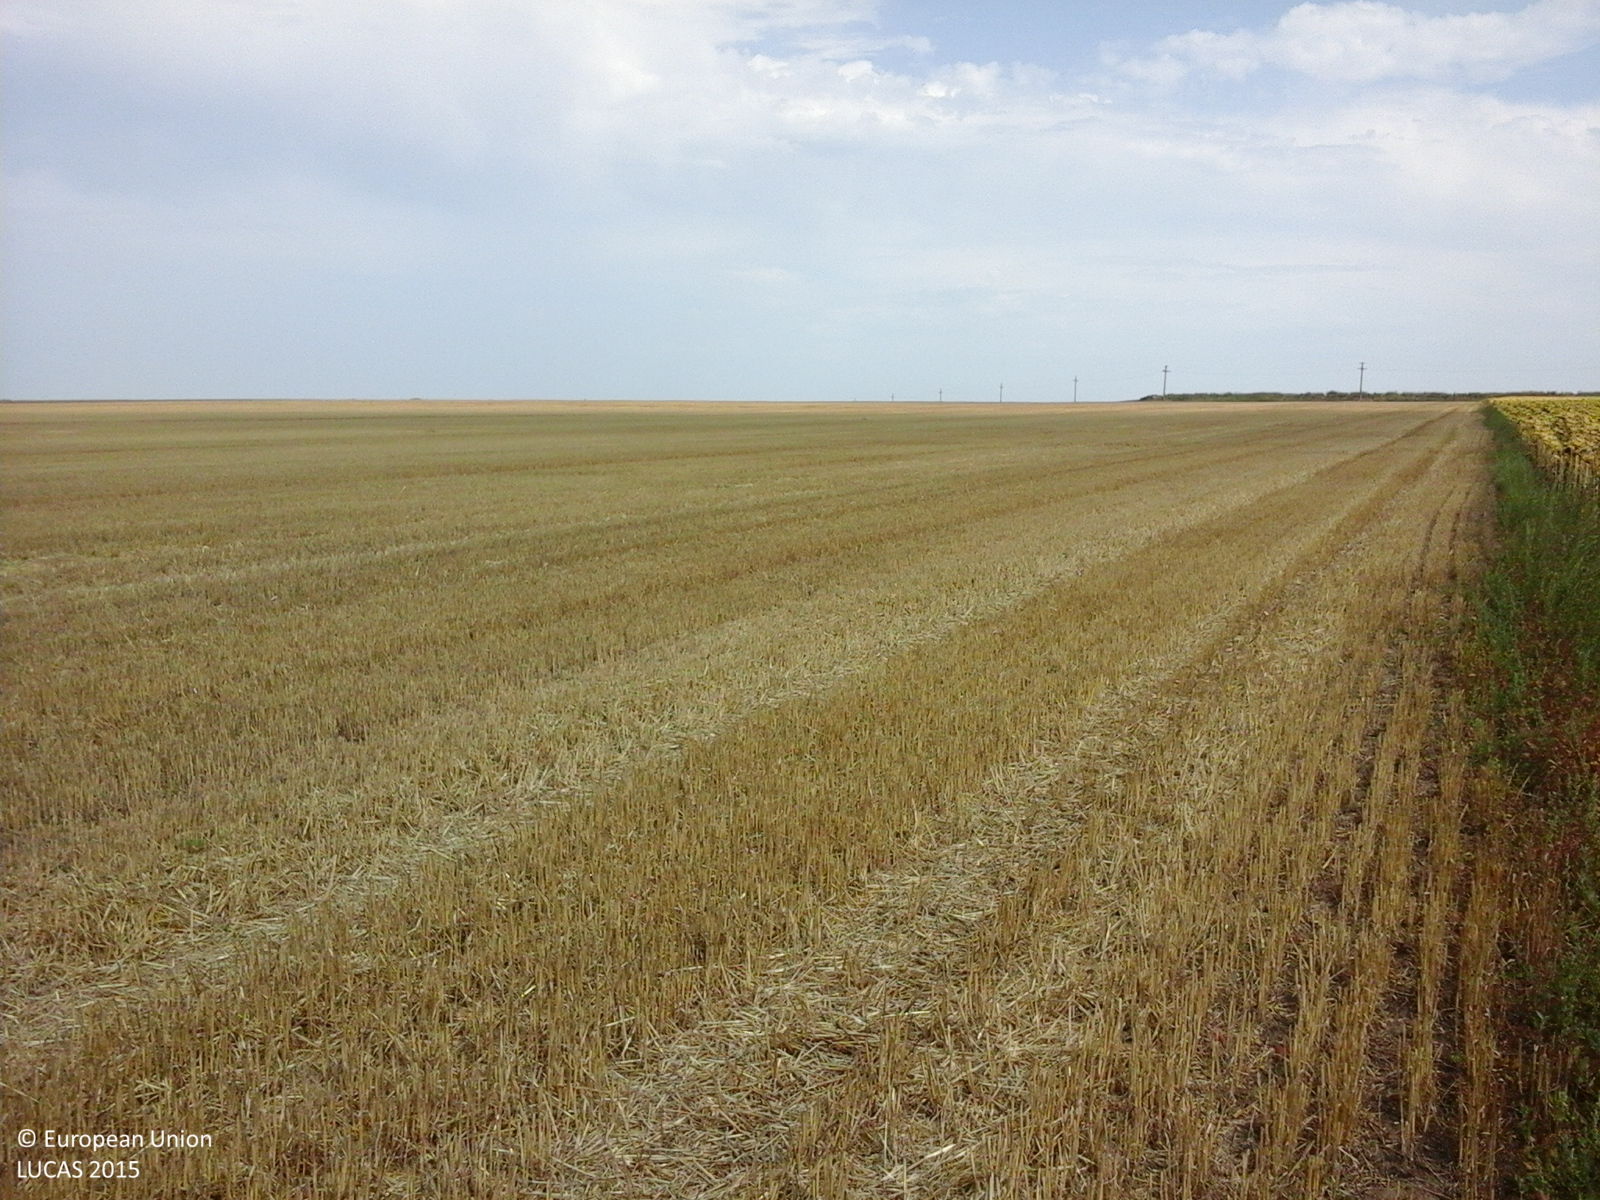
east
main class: Cropland
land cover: Sunflower
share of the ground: > 75 %
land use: Agriculture (excluding fallow land and kitchen gardens)
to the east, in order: Sunflower; Common wheat
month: August
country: RO
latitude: 43.9098
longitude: 28.3799
